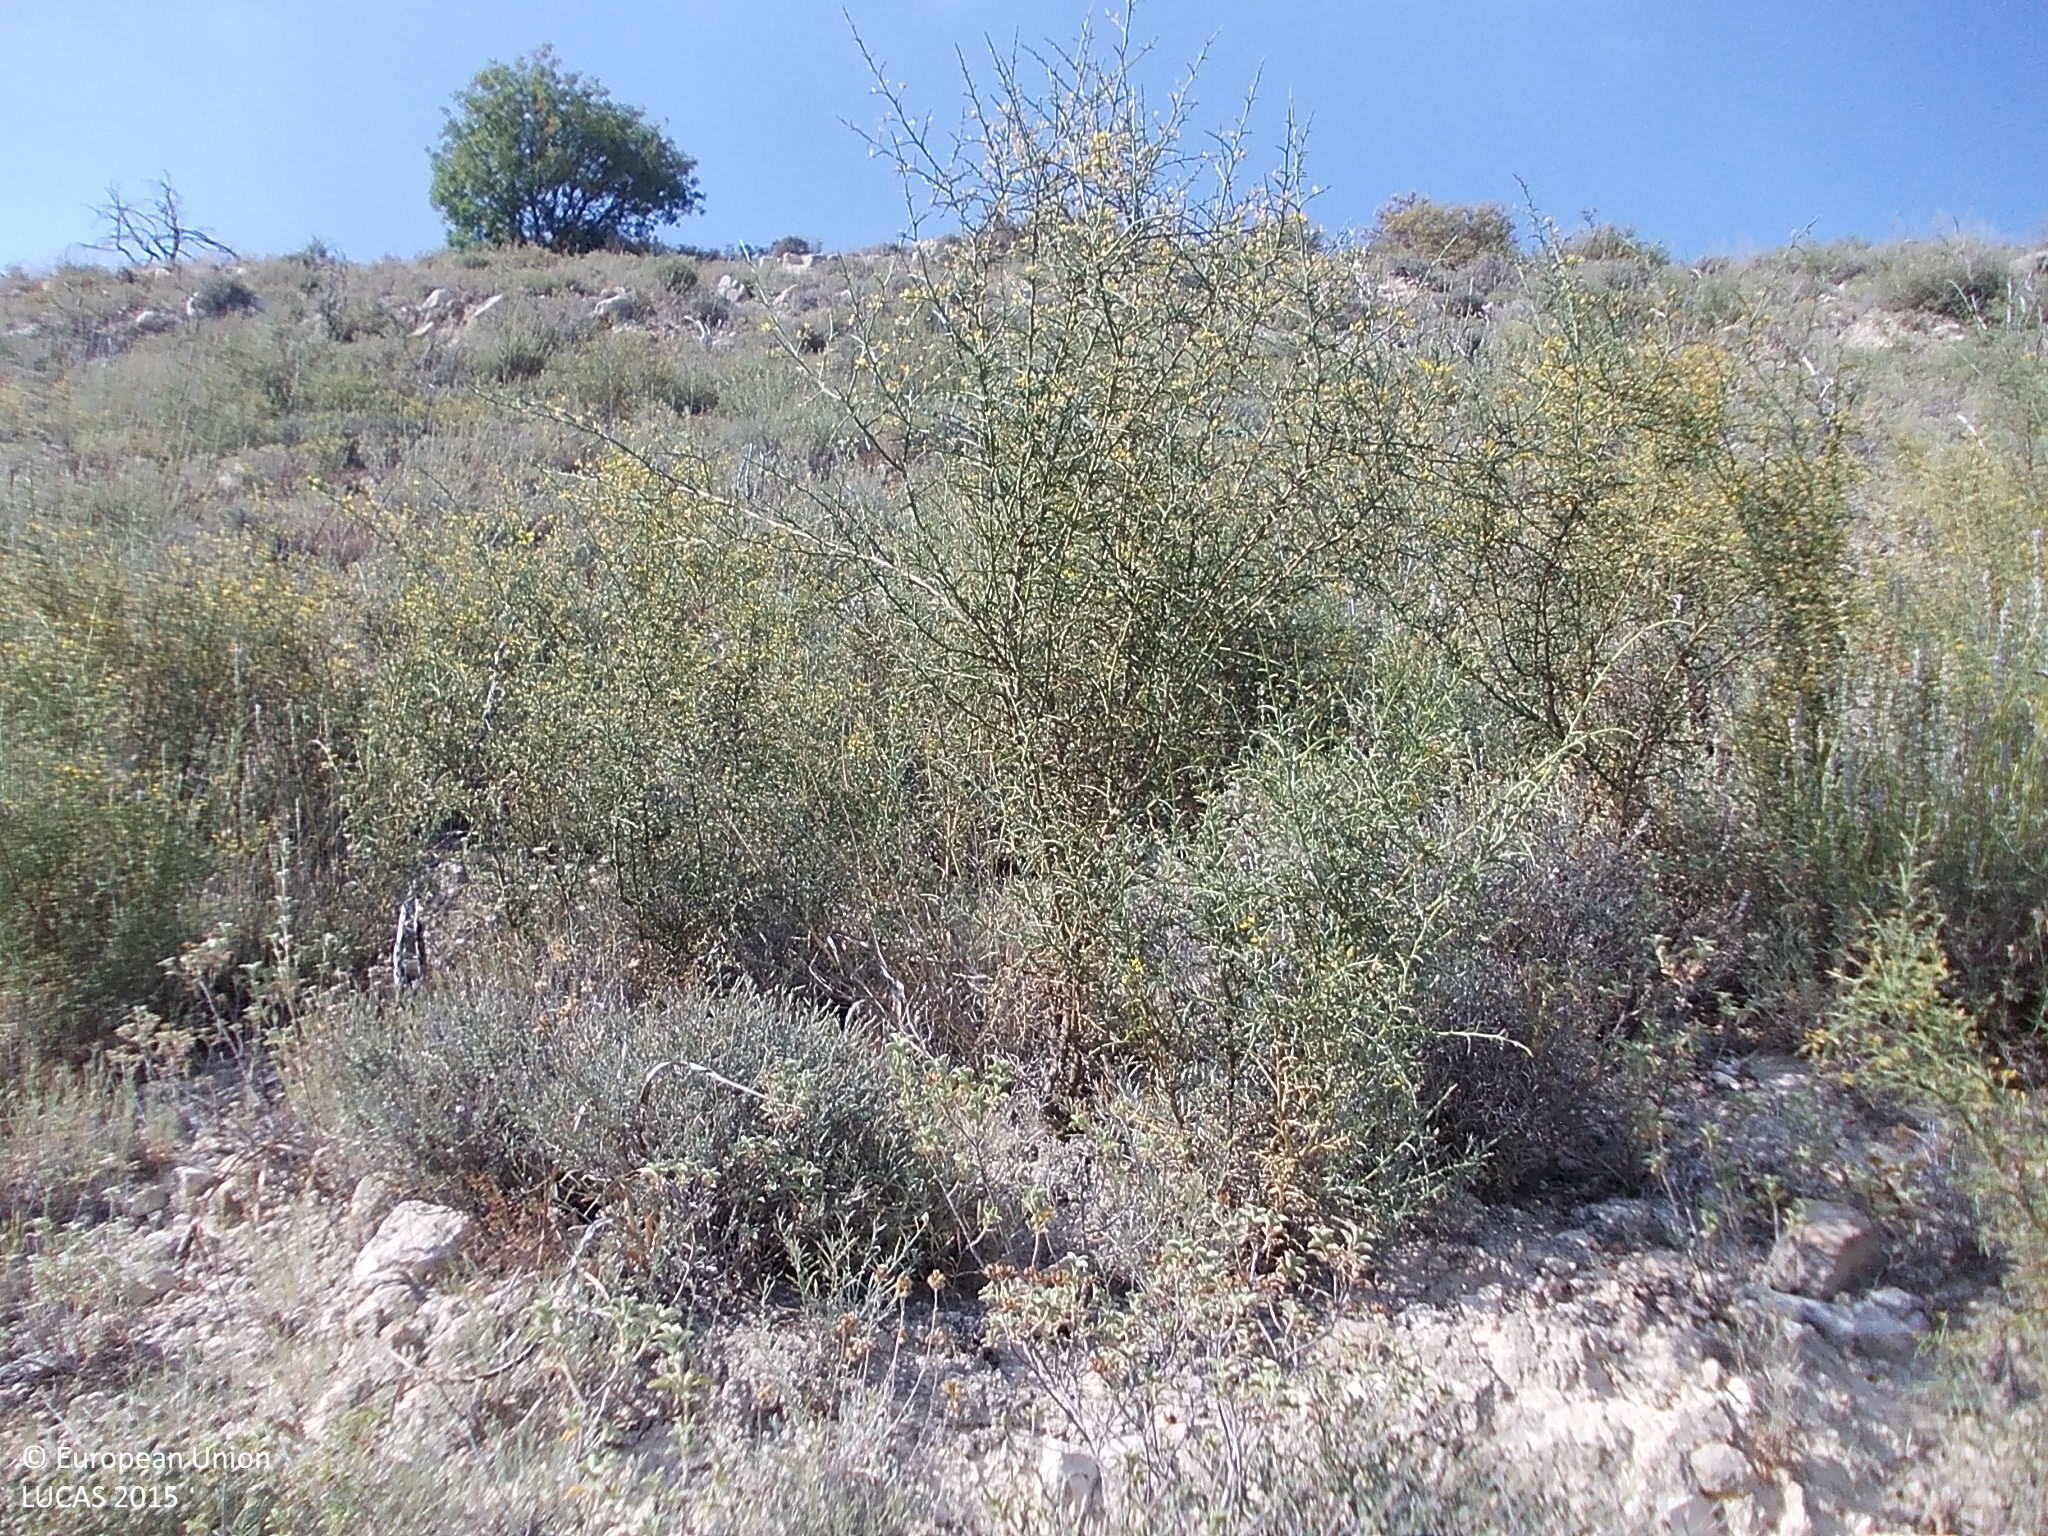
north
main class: Shrubland
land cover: Shrubland without tree cover
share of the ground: > 75 %
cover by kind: shrubs 80 %, herbaceous plants 10 %, unconsolidated bare surface 10 %
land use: Semi-natural and natural areas not in use
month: July
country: CY
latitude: 34.7664
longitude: 32.7397
